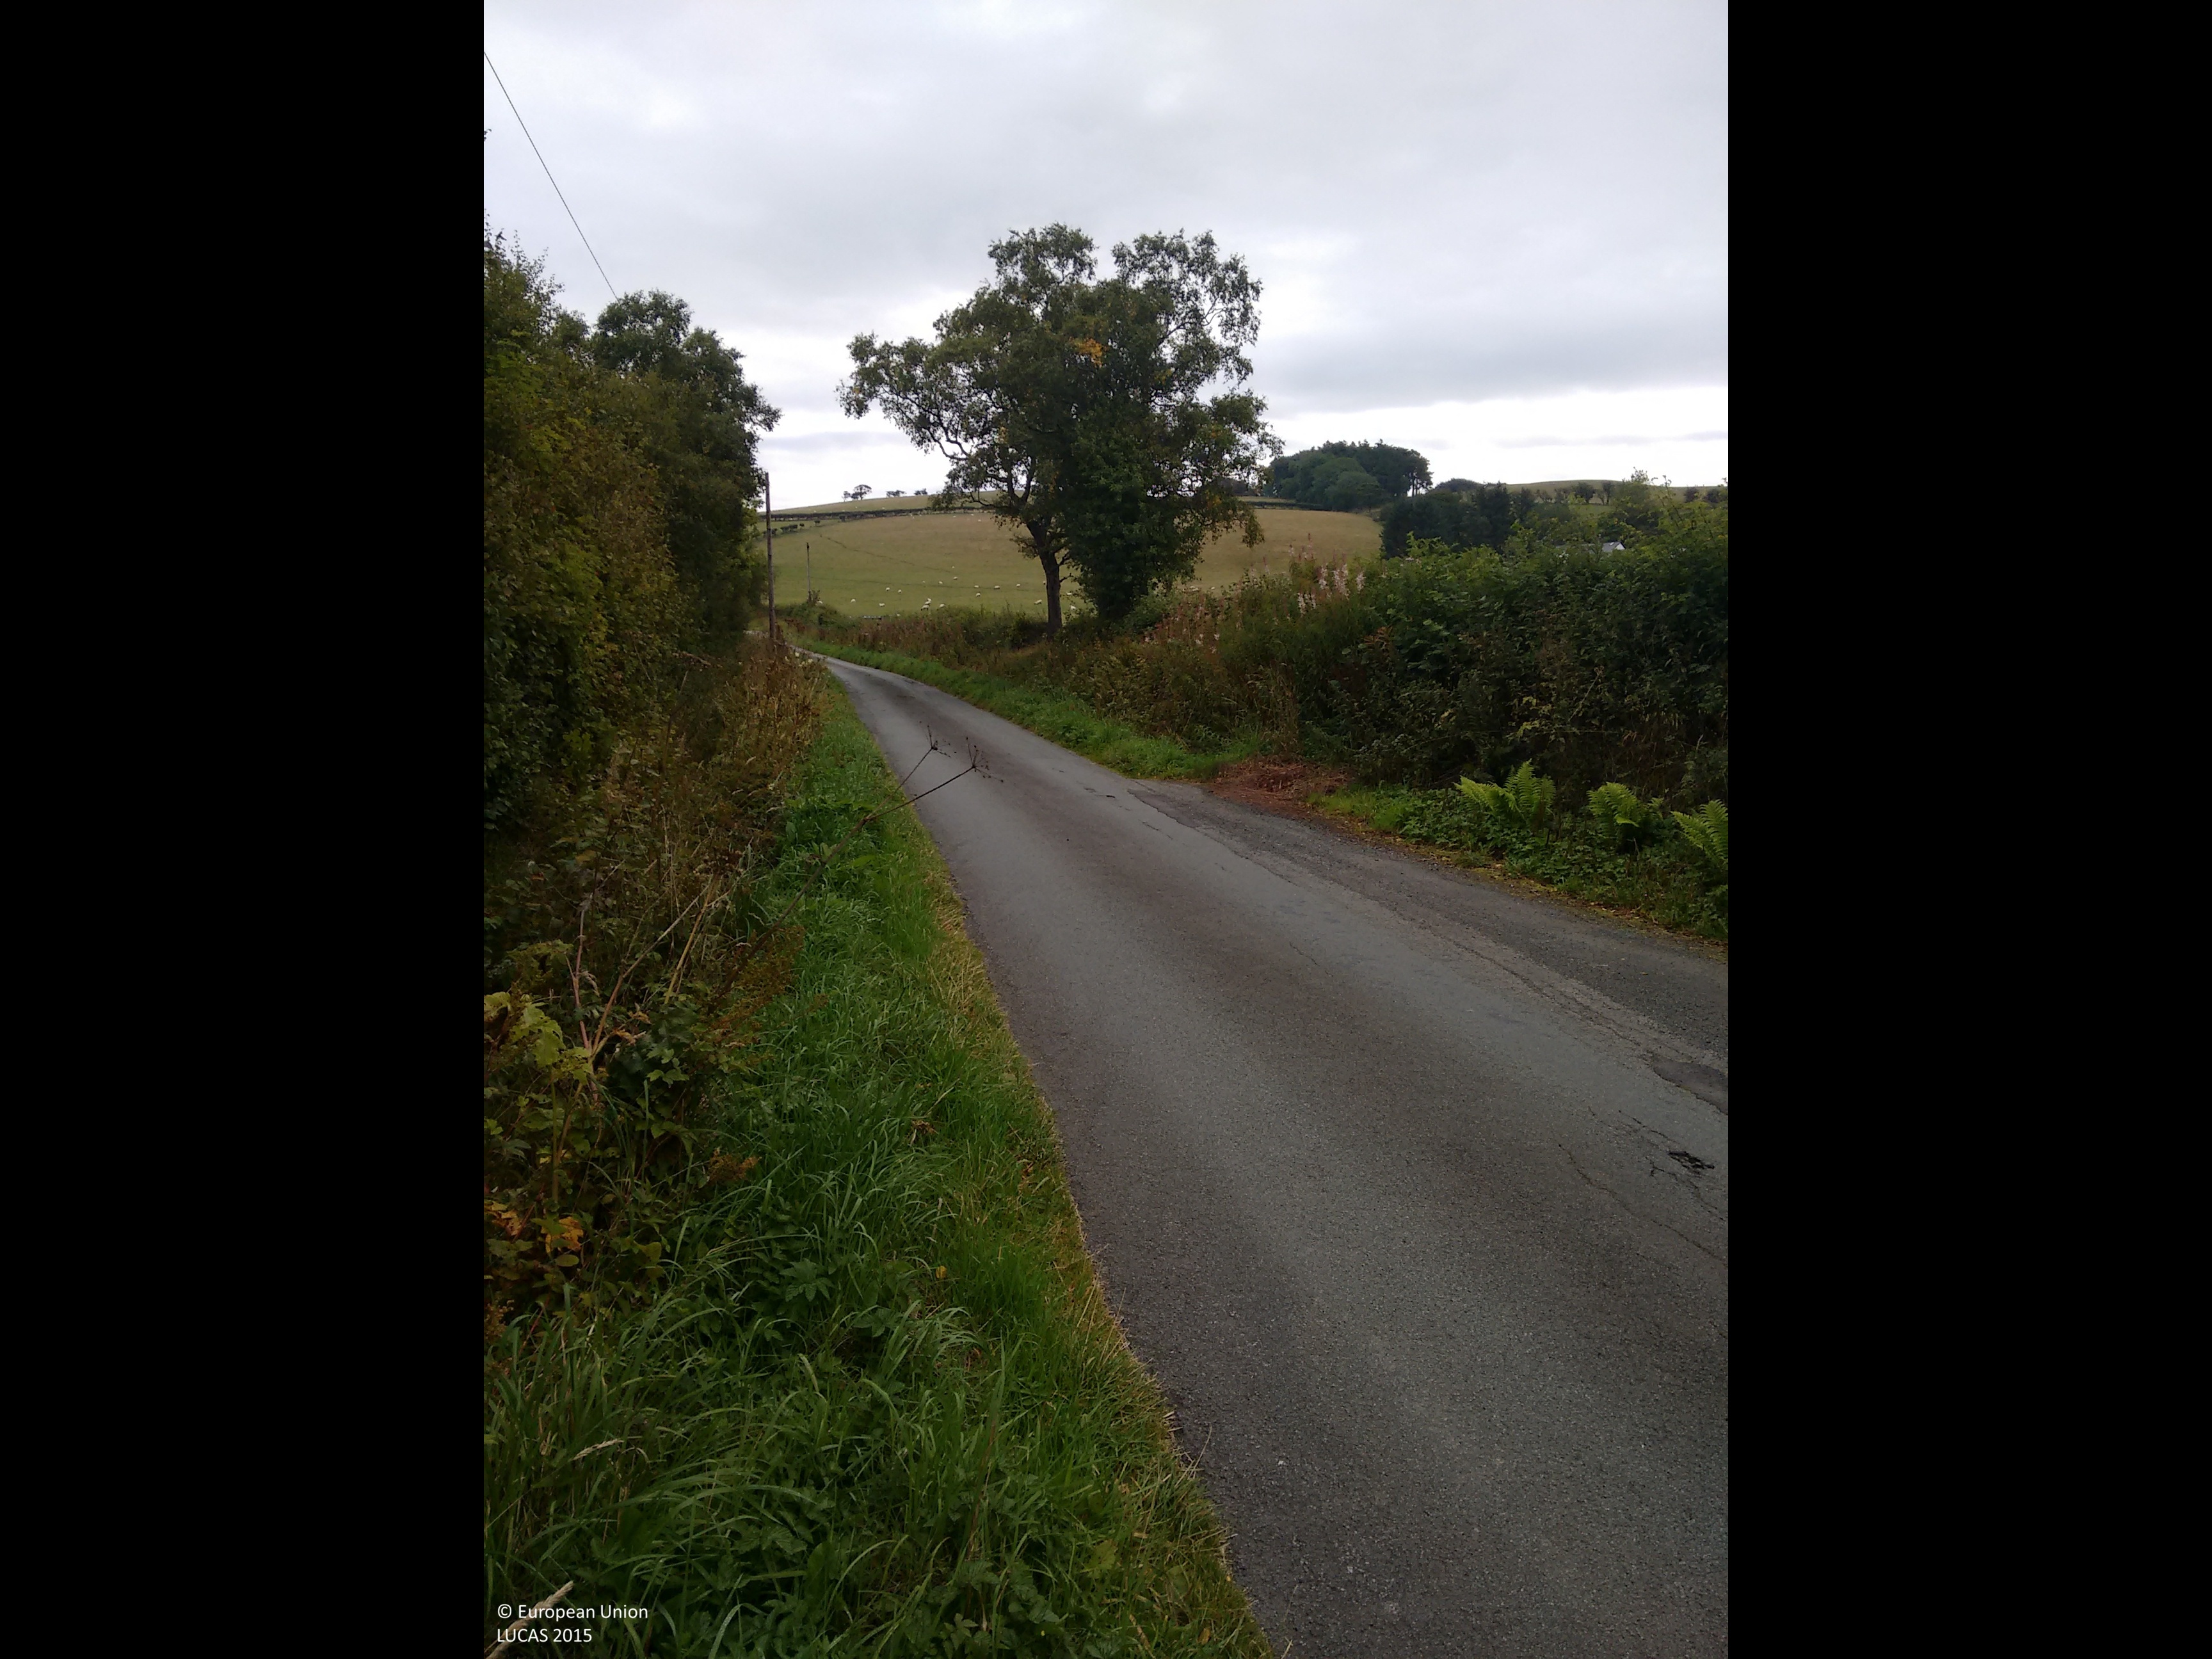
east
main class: Grassland
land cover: Grassland without tree/shrub cover
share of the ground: > 75 %
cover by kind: herbaceous plants 100 %
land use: Agriculture (excluding fallow land and kitchen gardens)
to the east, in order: Grassland without tree/shrub cover; Fences; Grass margins; Paved roads, cycling and walking lanes; Grass margins; Electric lines; Ditches and canals; Managed hedges; Fences; Grassland without tree/shrub cover
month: September
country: GB
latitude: 53.0346
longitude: -3.2470
